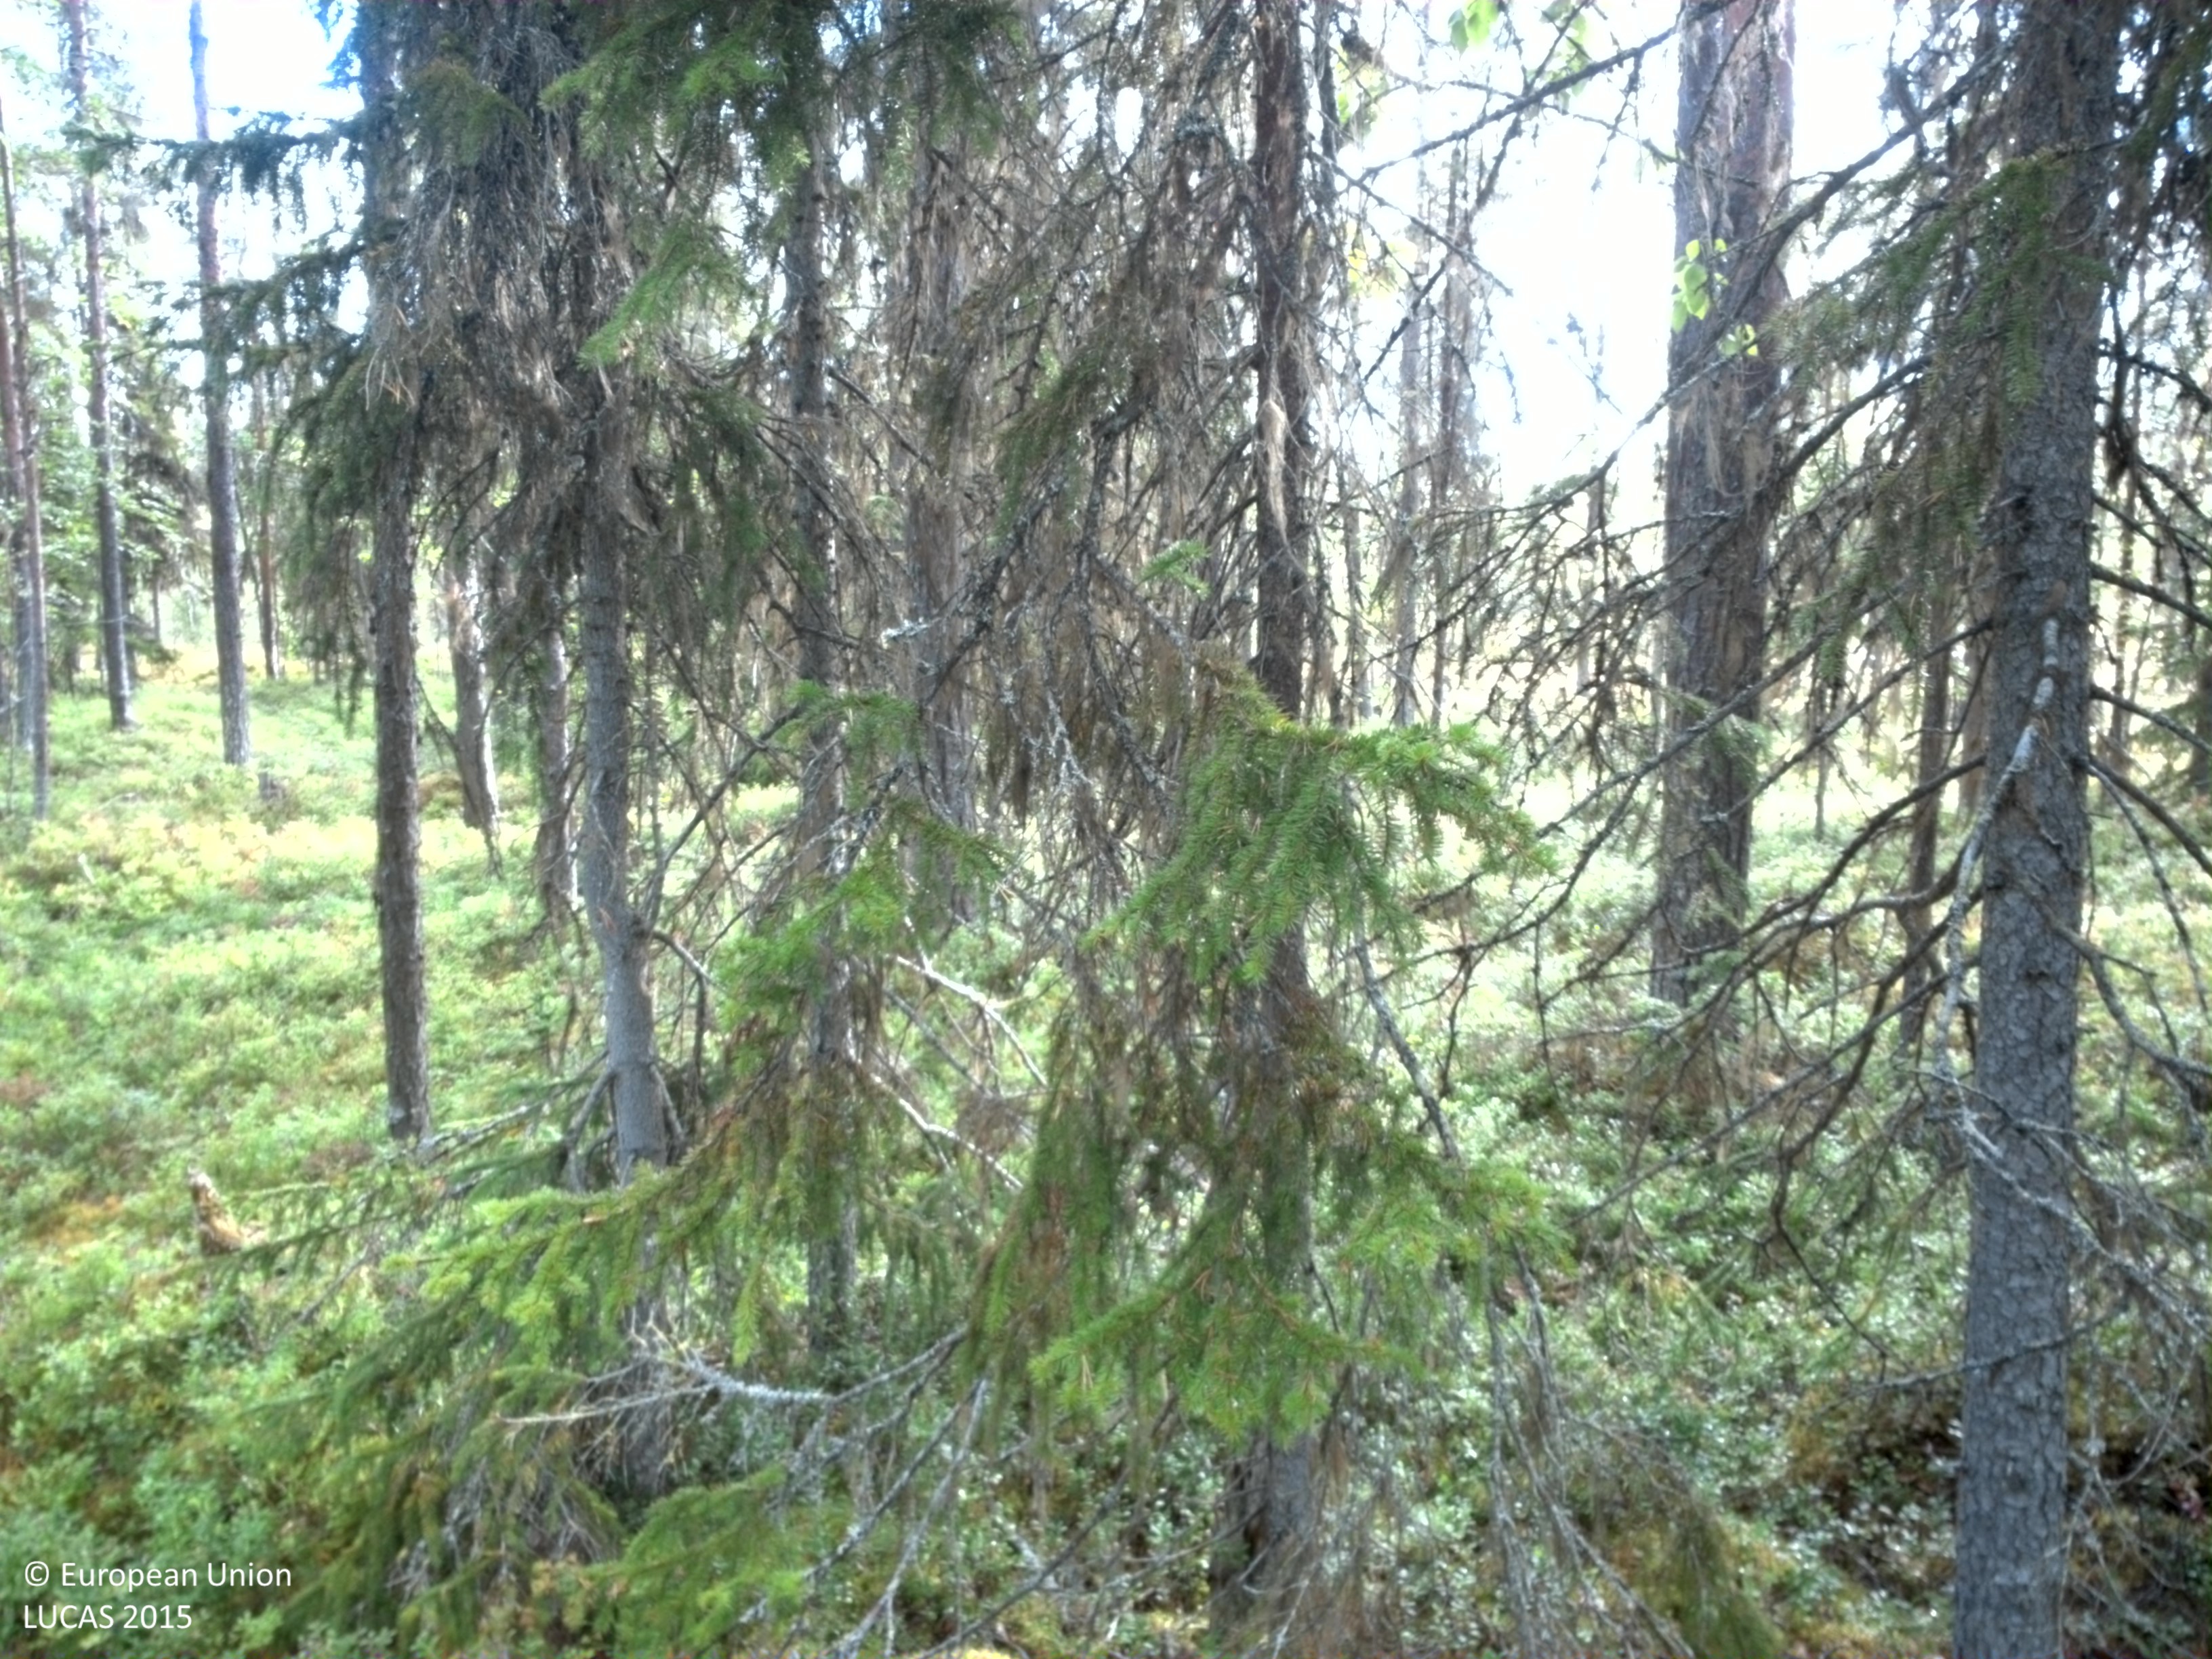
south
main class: Woodland
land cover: Pine dominated coniferous woodland
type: boreal forest
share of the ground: 25 - 50 %
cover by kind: shrubs 50 %, coniferous forest trees 35 %, lichens and mosses 10 %, broadleaved forest trees 5 %
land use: Forestry
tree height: > 5 m
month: September
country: SE
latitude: 65.1302
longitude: 17.0593
